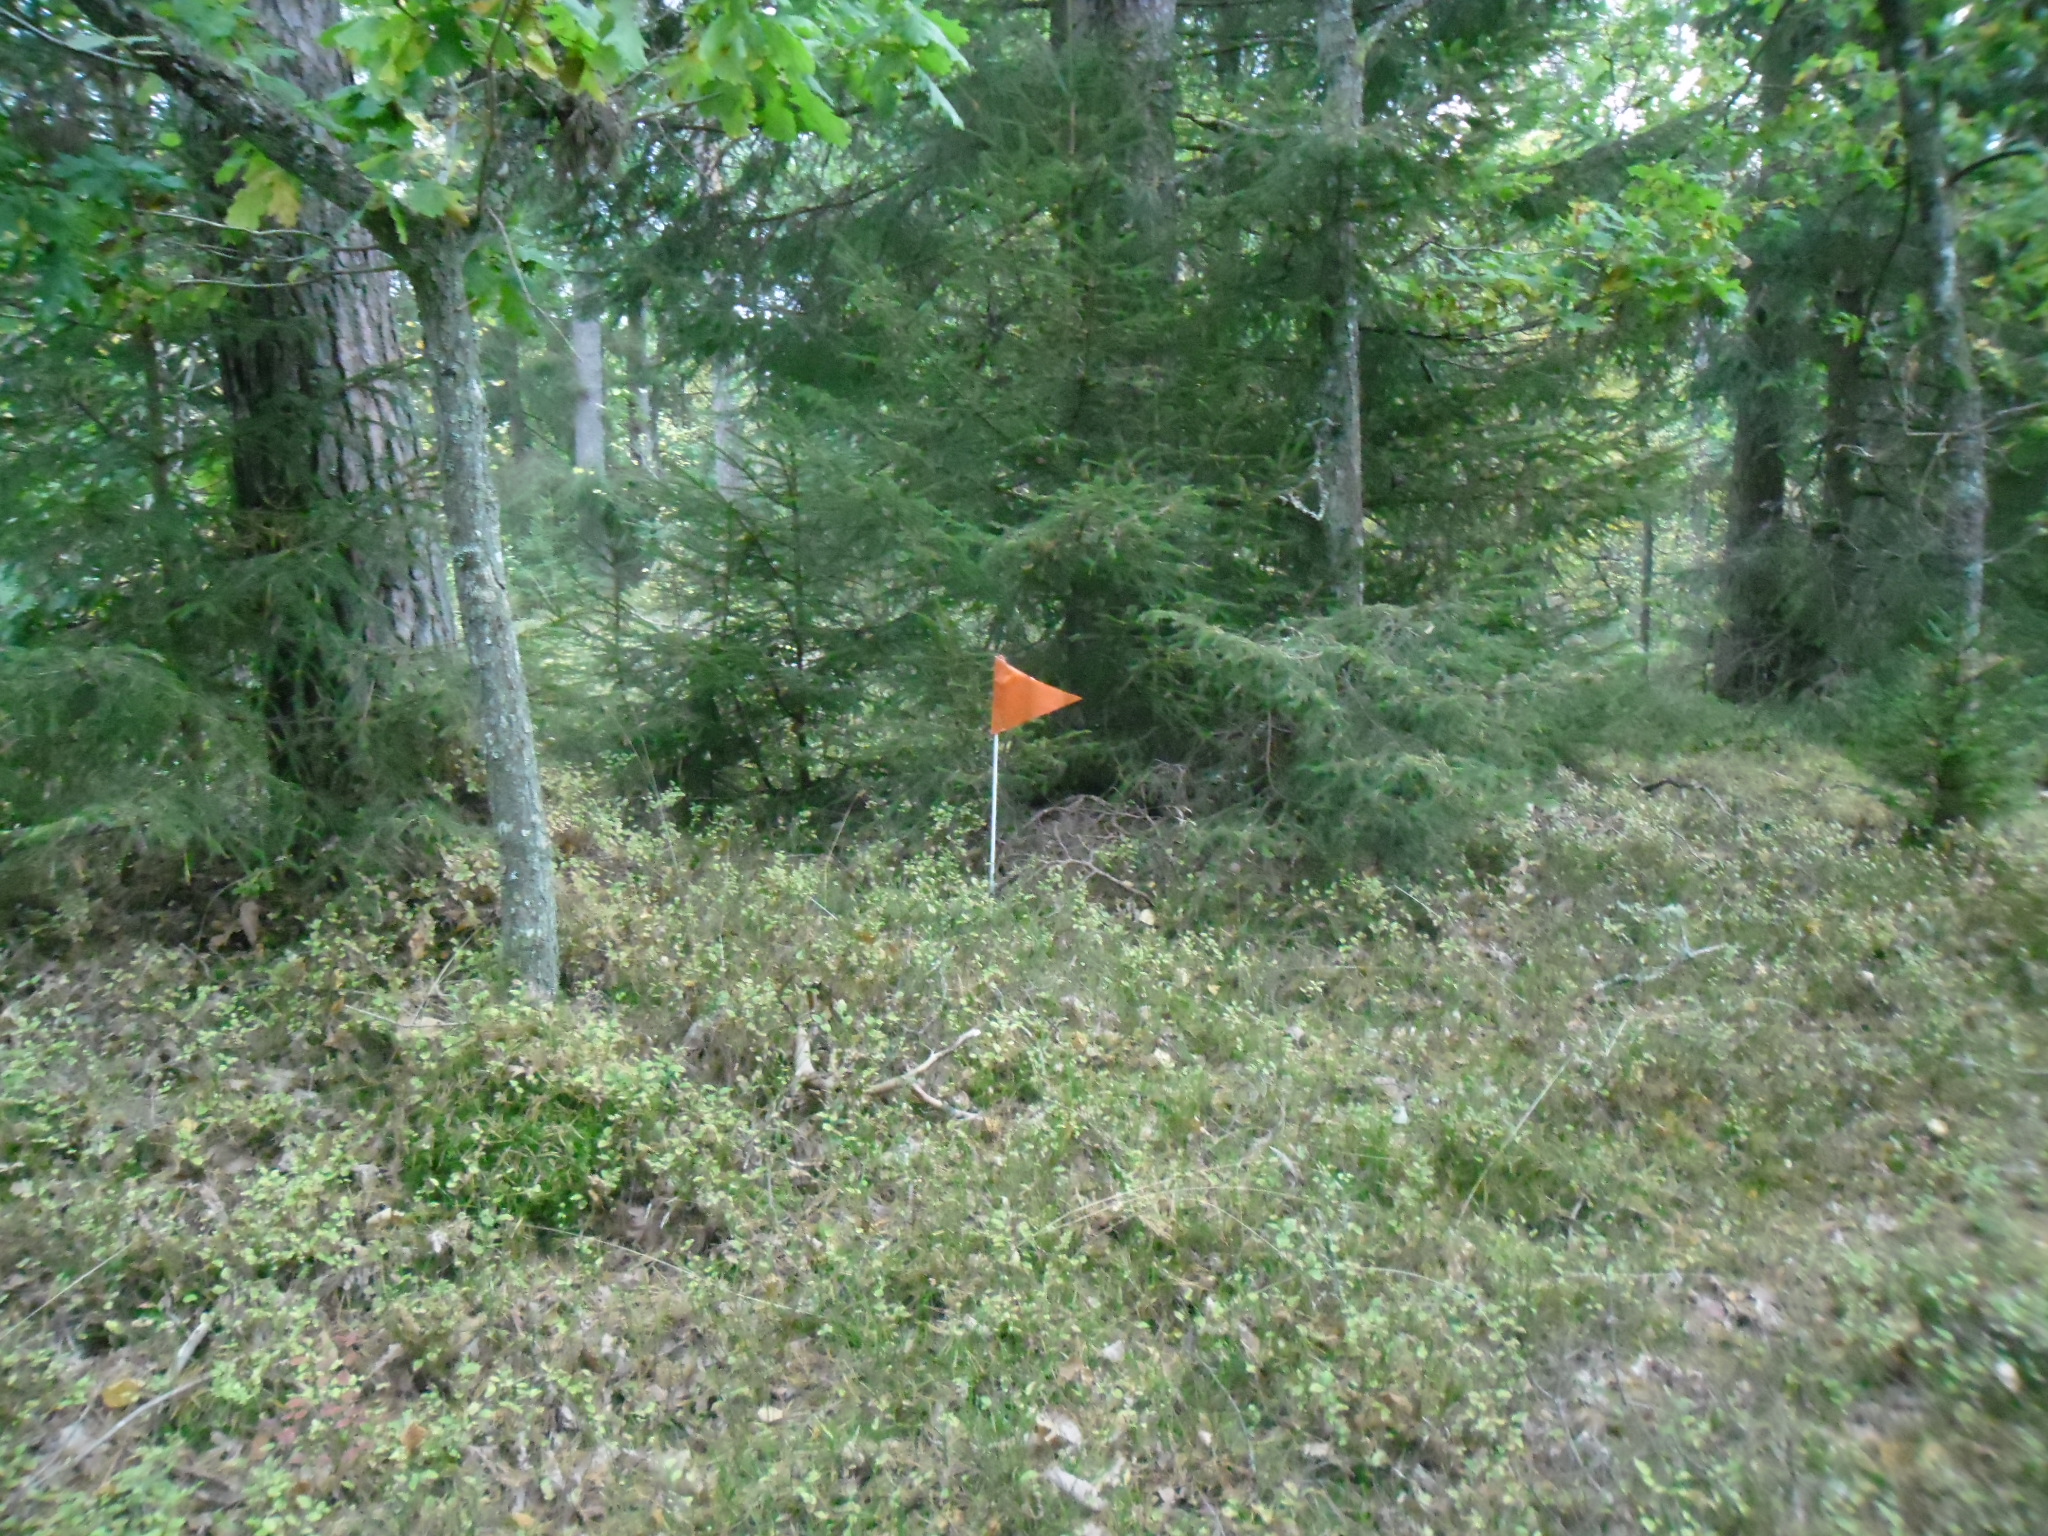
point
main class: Woodland
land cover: Spruce dominated mixed woodland
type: hemiboreal forest and nemoral coniferous forest and mixed broadleaved-coniferous forest
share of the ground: 50 - 75 %
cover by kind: coniferous forest trees 45 %, shrubs 30 %, broadleaved forest trees 15 %, herbaceous plants 10 %
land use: Forestry
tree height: > 5 m
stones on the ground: 25 - 50 %
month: October
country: SE
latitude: 56.3655
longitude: 13.8014
